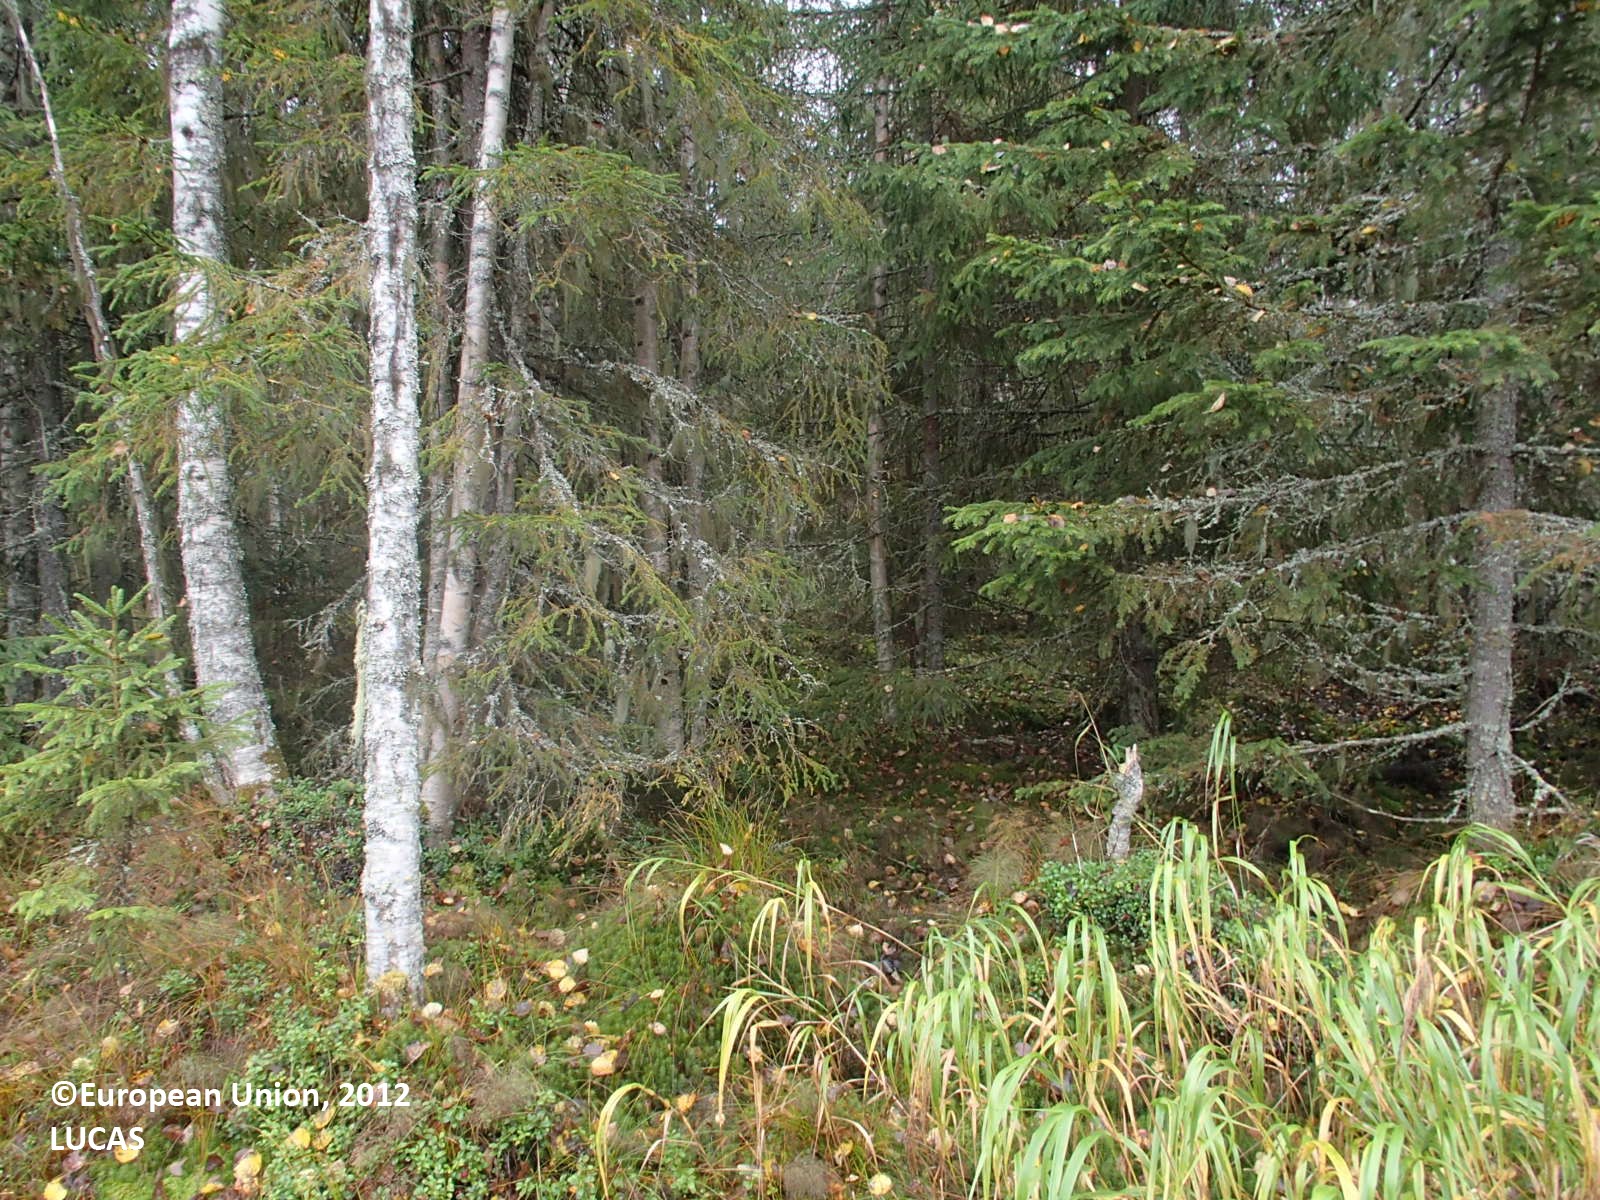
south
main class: Grassland
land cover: Spontaneously vegetated surfaces
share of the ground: > 75 %
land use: Fallow land
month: September
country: FI
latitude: 63.8249
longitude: 26.8132
